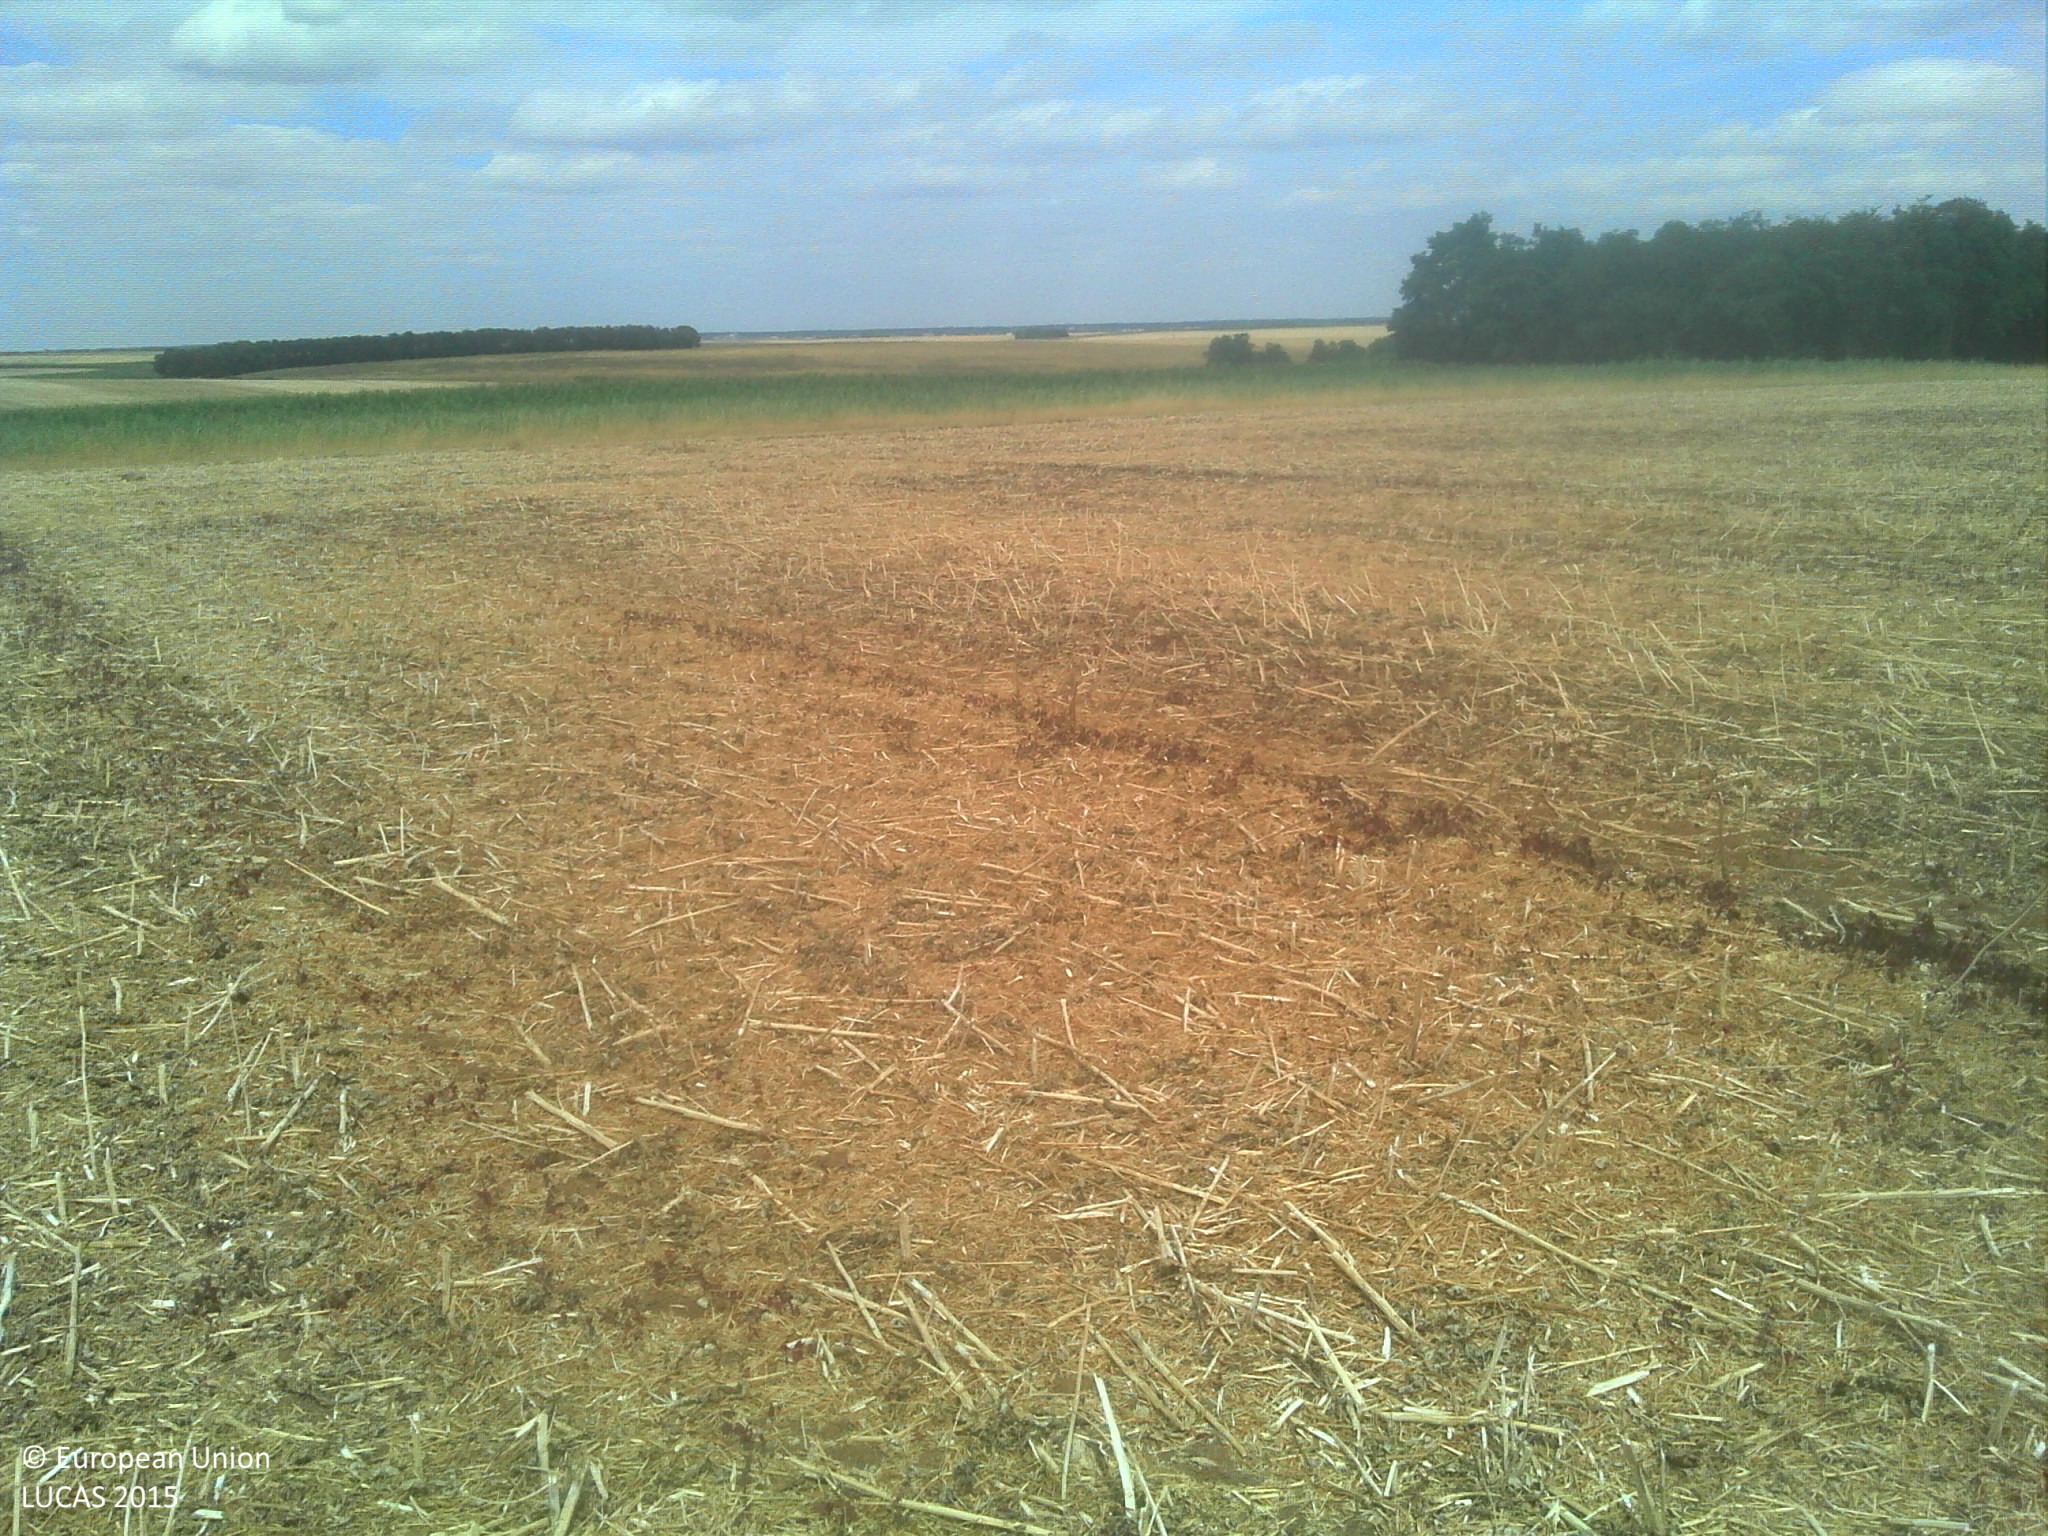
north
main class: Cropland
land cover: Rape and turnip rape
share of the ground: < 10 %
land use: Agriculture (excluding fallow land and kitchen gardens)
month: July
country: FR
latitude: 47.7587
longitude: 1.3797
